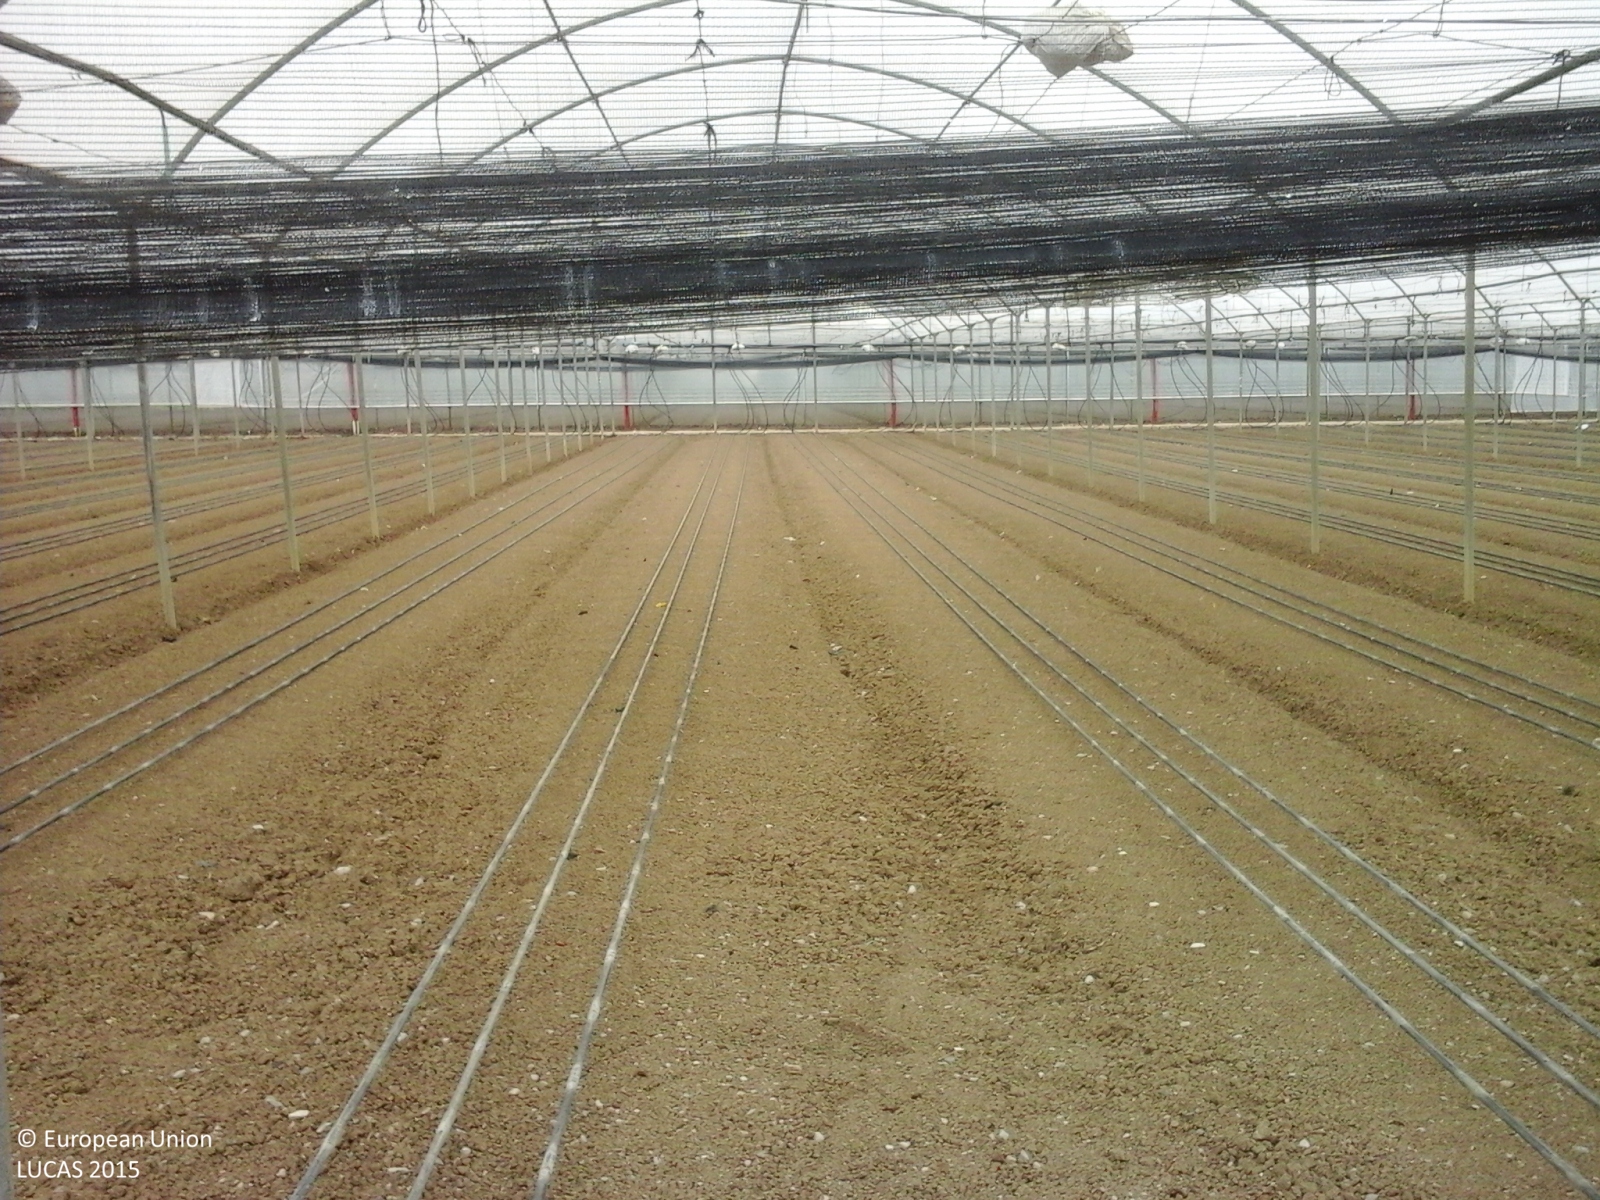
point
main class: Artificial land
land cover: Greenhouses
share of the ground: > 75 %
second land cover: Other fresh vegetables
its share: > 75 %
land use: Agriculture (excluding fallow land and kitchen gardens)
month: May
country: IT
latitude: 40.5725
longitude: 15.0465
